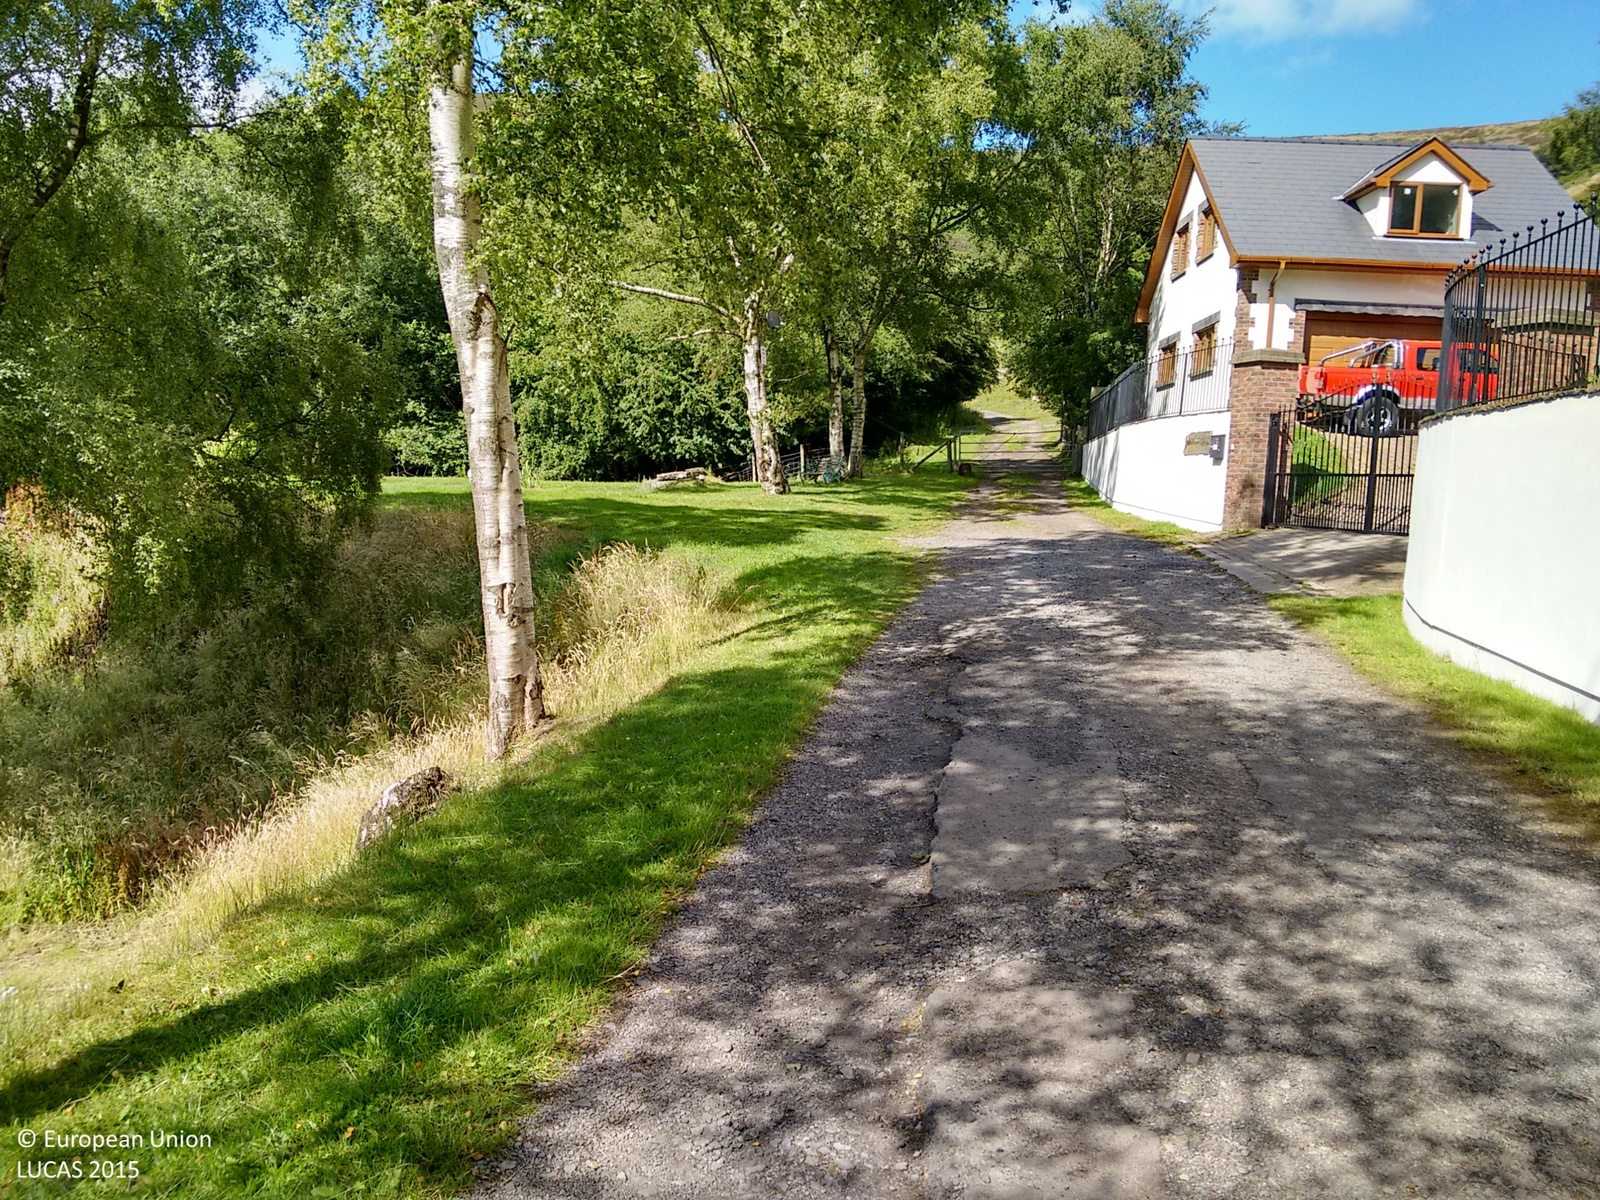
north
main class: Grassland
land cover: Grassland without tree/shrub cover
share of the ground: > 75 %
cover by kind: herbaceous plants 100 %
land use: Residential
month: July
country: GB
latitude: 51.7358
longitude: -3.1244
